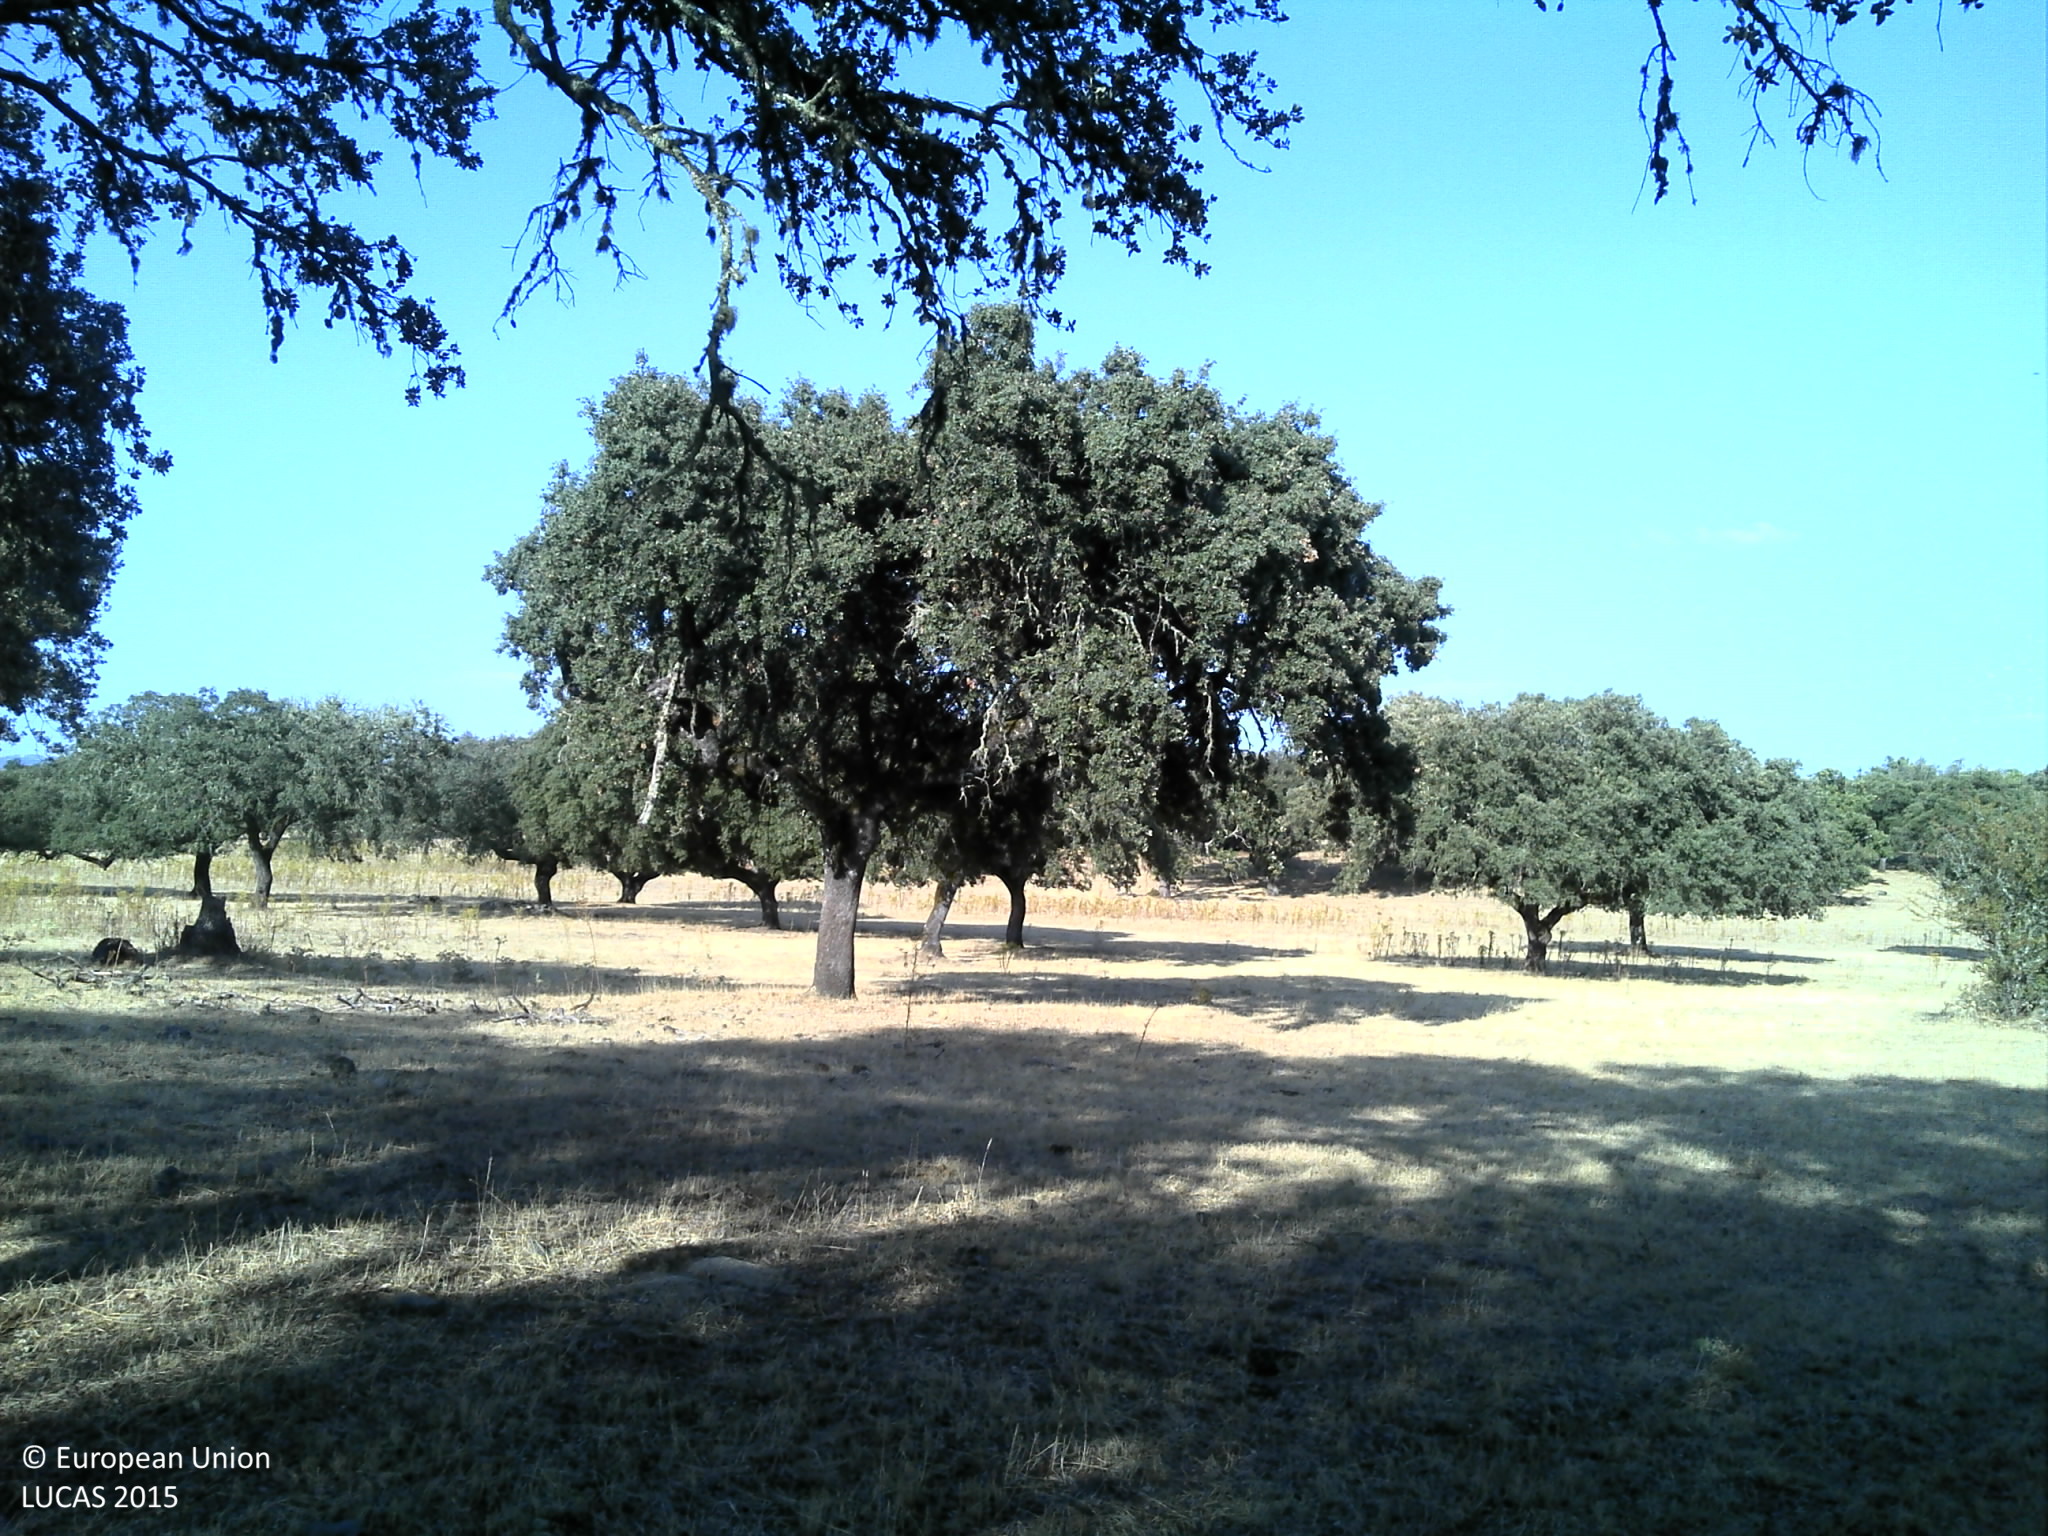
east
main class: Woodland
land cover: Broadleaved woodland
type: broadleaved evergreen forest
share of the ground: 25 - 50 %
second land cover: Grassland without tree/shrub cover
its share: 10 - 25 %
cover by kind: unconsolidated bare surface 55 %, broadleaved forest trees 30 %, herbaceous plants 15 %
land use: Forestry
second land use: Agriculture (excluding fallow land and kitchen gardens)
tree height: > 5 m
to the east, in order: Broadleaved woodland; Grassland without tree/shrub cover; Broadleaved woodland; Grassland without tree/shrub cover; Tracks; Grassland without tree/shrub cover; Broadleaved woodland
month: August
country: PT
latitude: 39.3181
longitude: -7.5473
